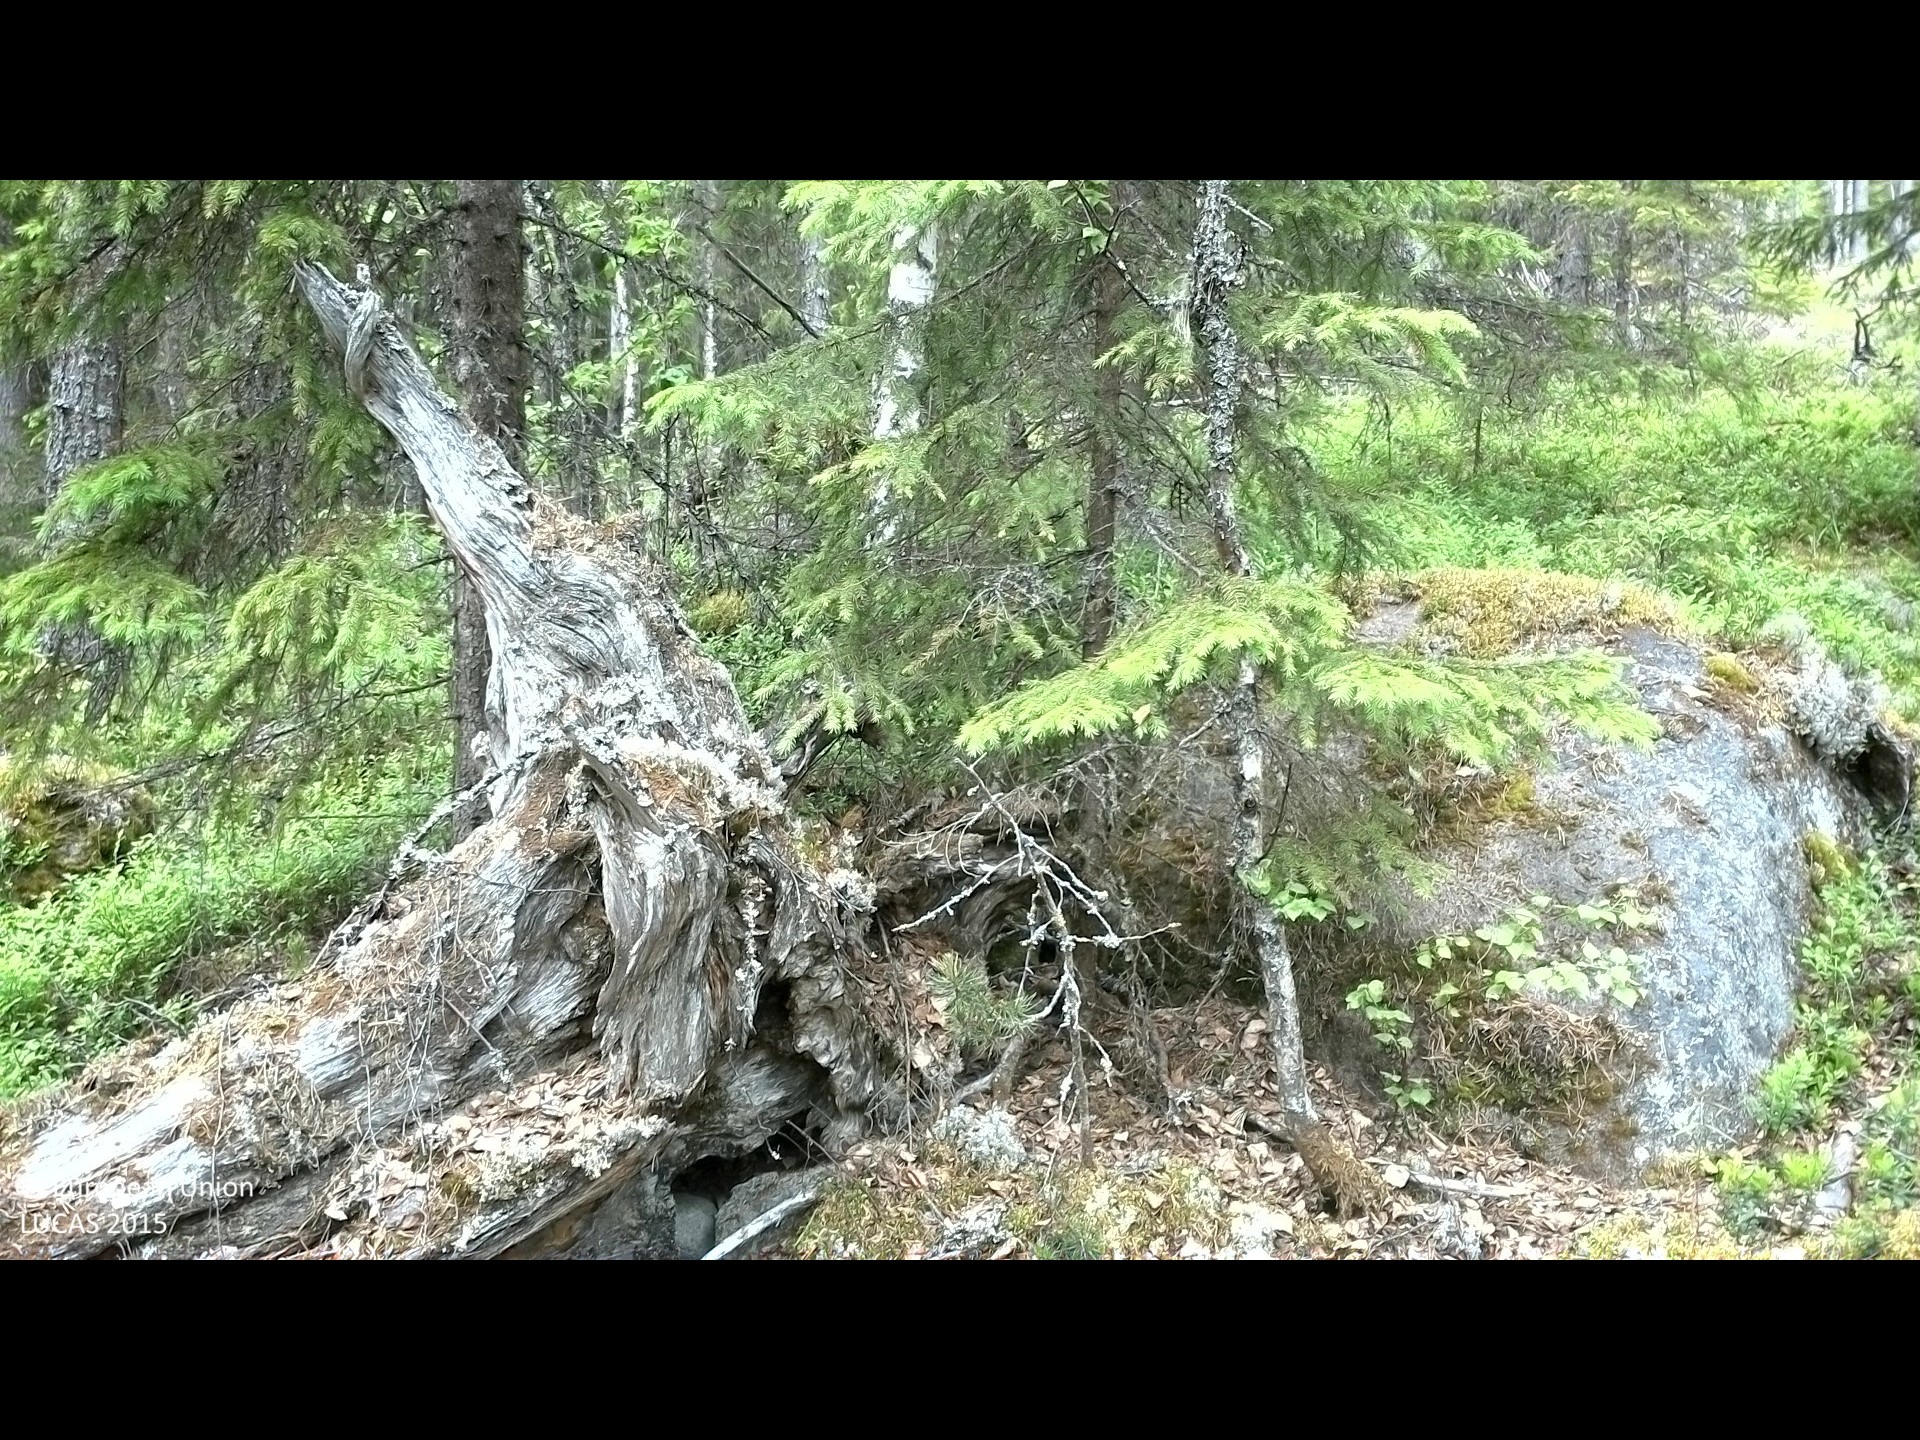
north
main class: Woodland
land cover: Spruce dominated mixed woodland
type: boreal forest
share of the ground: 25 - 50 %
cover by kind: lichens and mosses 35 %, shrubs 30 %, coniferous forest trees 20 %, broadleaved forest trees 15 %
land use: Forestry
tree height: > 5 m
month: June
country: SE
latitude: 61.9774
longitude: 16.2208
